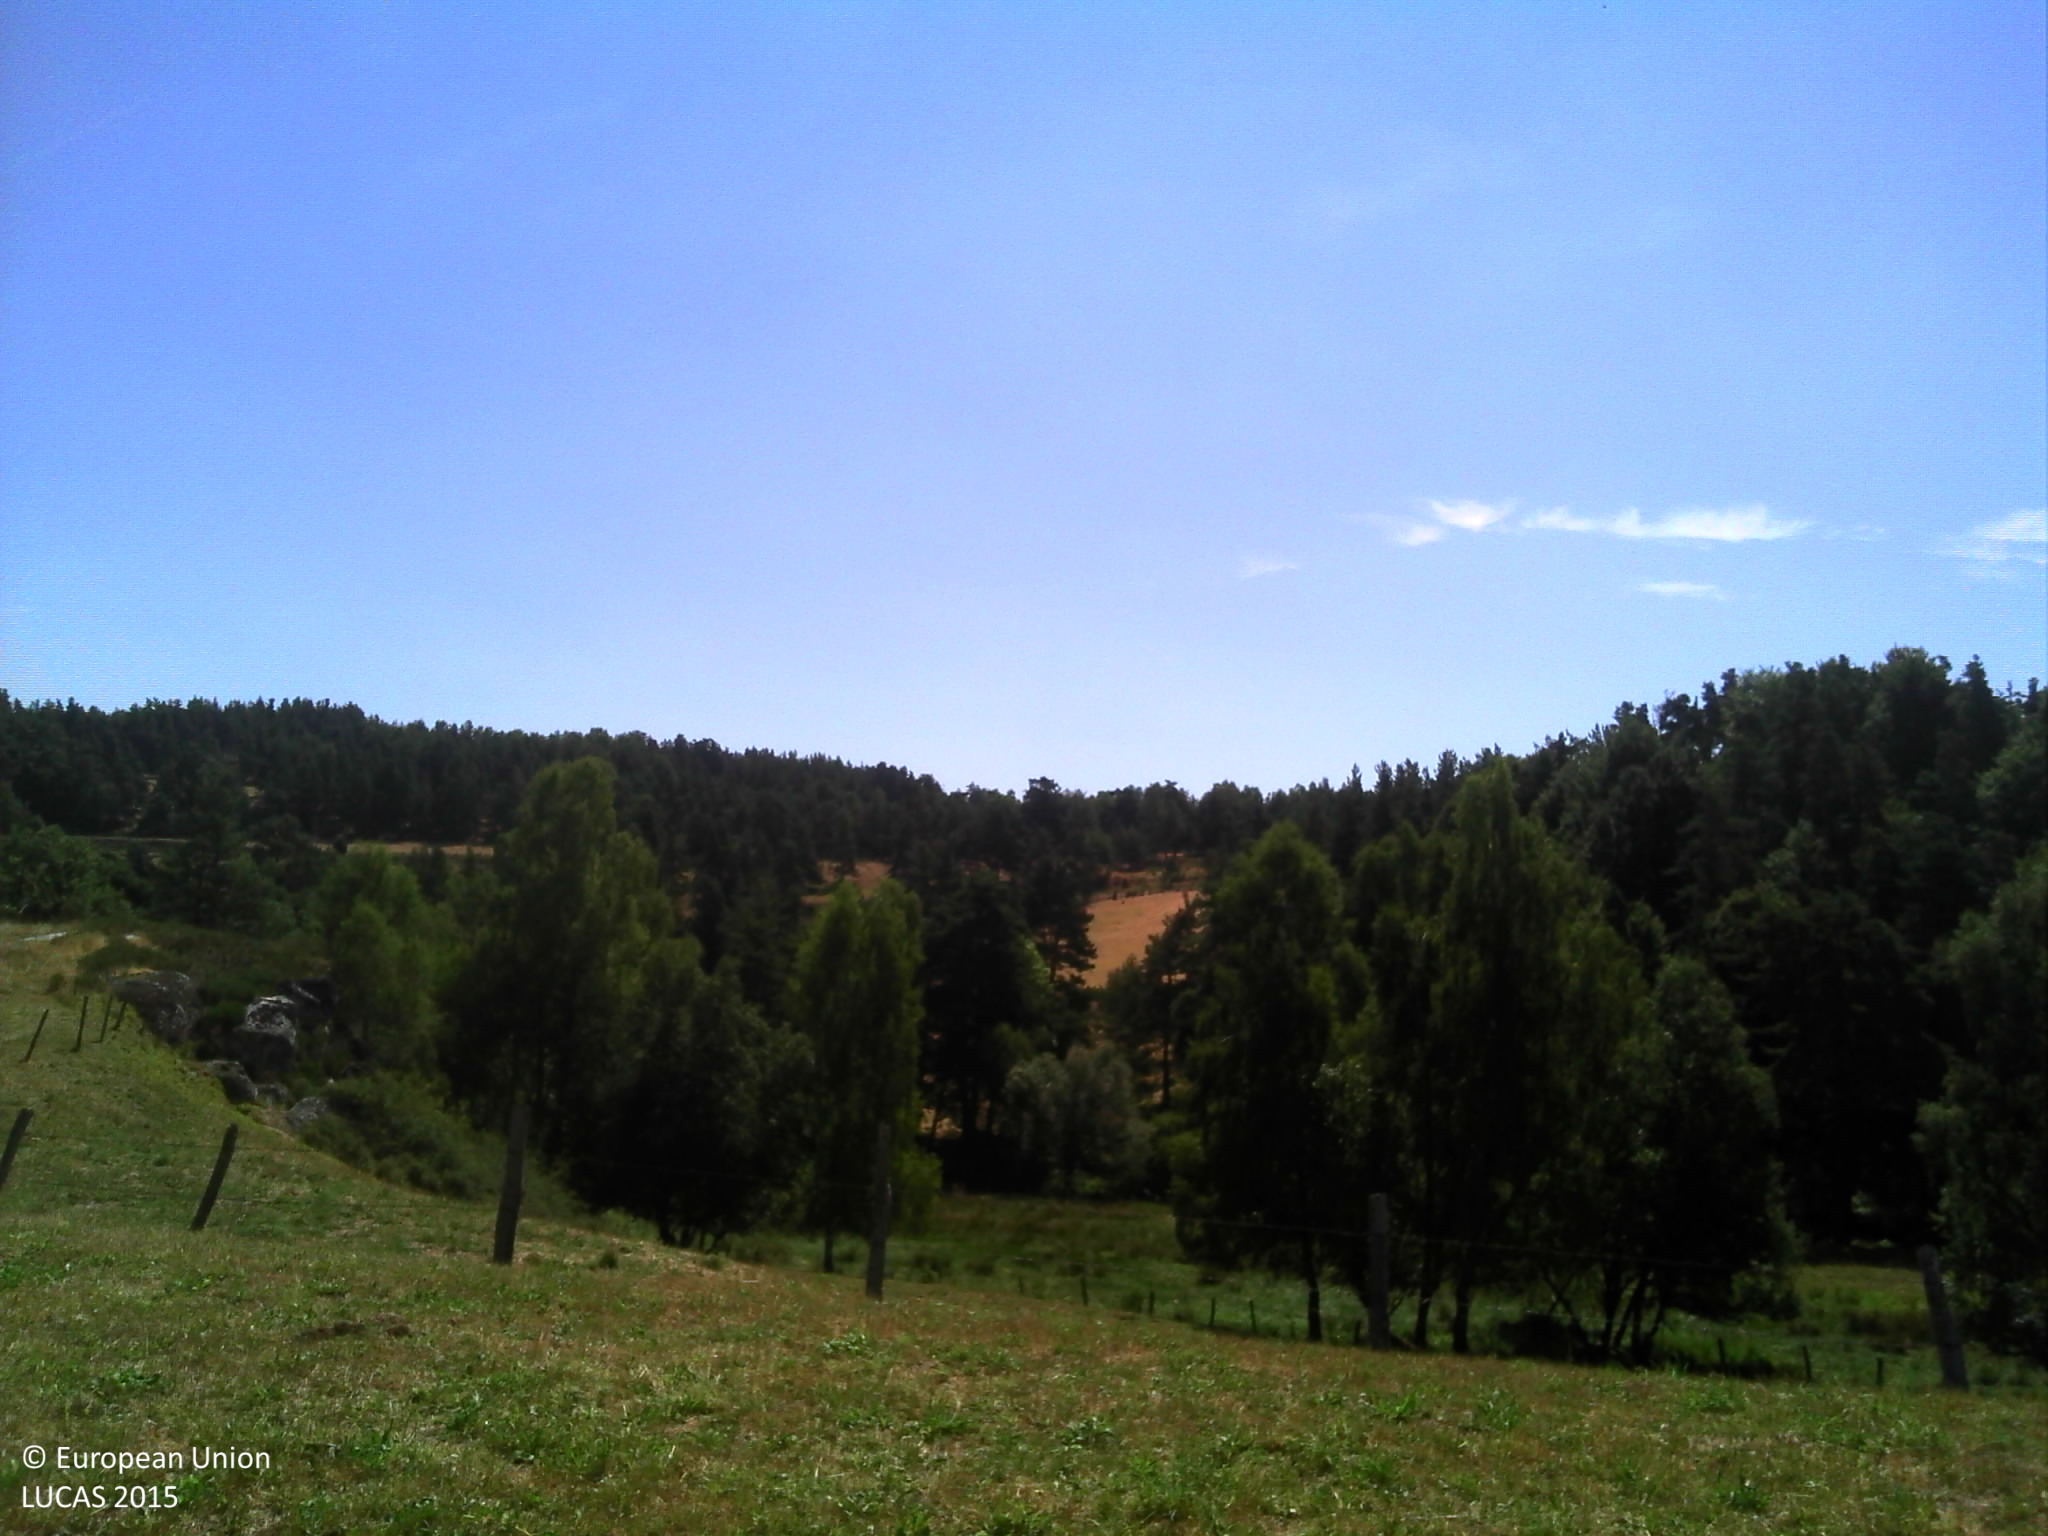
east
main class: Grassland
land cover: Grassland without tree/shrub cover
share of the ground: > 75 %
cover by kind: herbaceous plants 100 %
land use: Agriculture (excluding fallow land and kitchen gardens)
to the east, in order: Grassland without tree/shrub cover; Fences; Shrubland with sparse tree cover; Fences; Grassland without tree/shrub cover; Broadleaved woodland; Fences; Grassland without tree/shrub cover; Fences; Grassland without tree/shrub cover
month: July
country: FR
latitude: 44.7260
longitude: 3.2237
